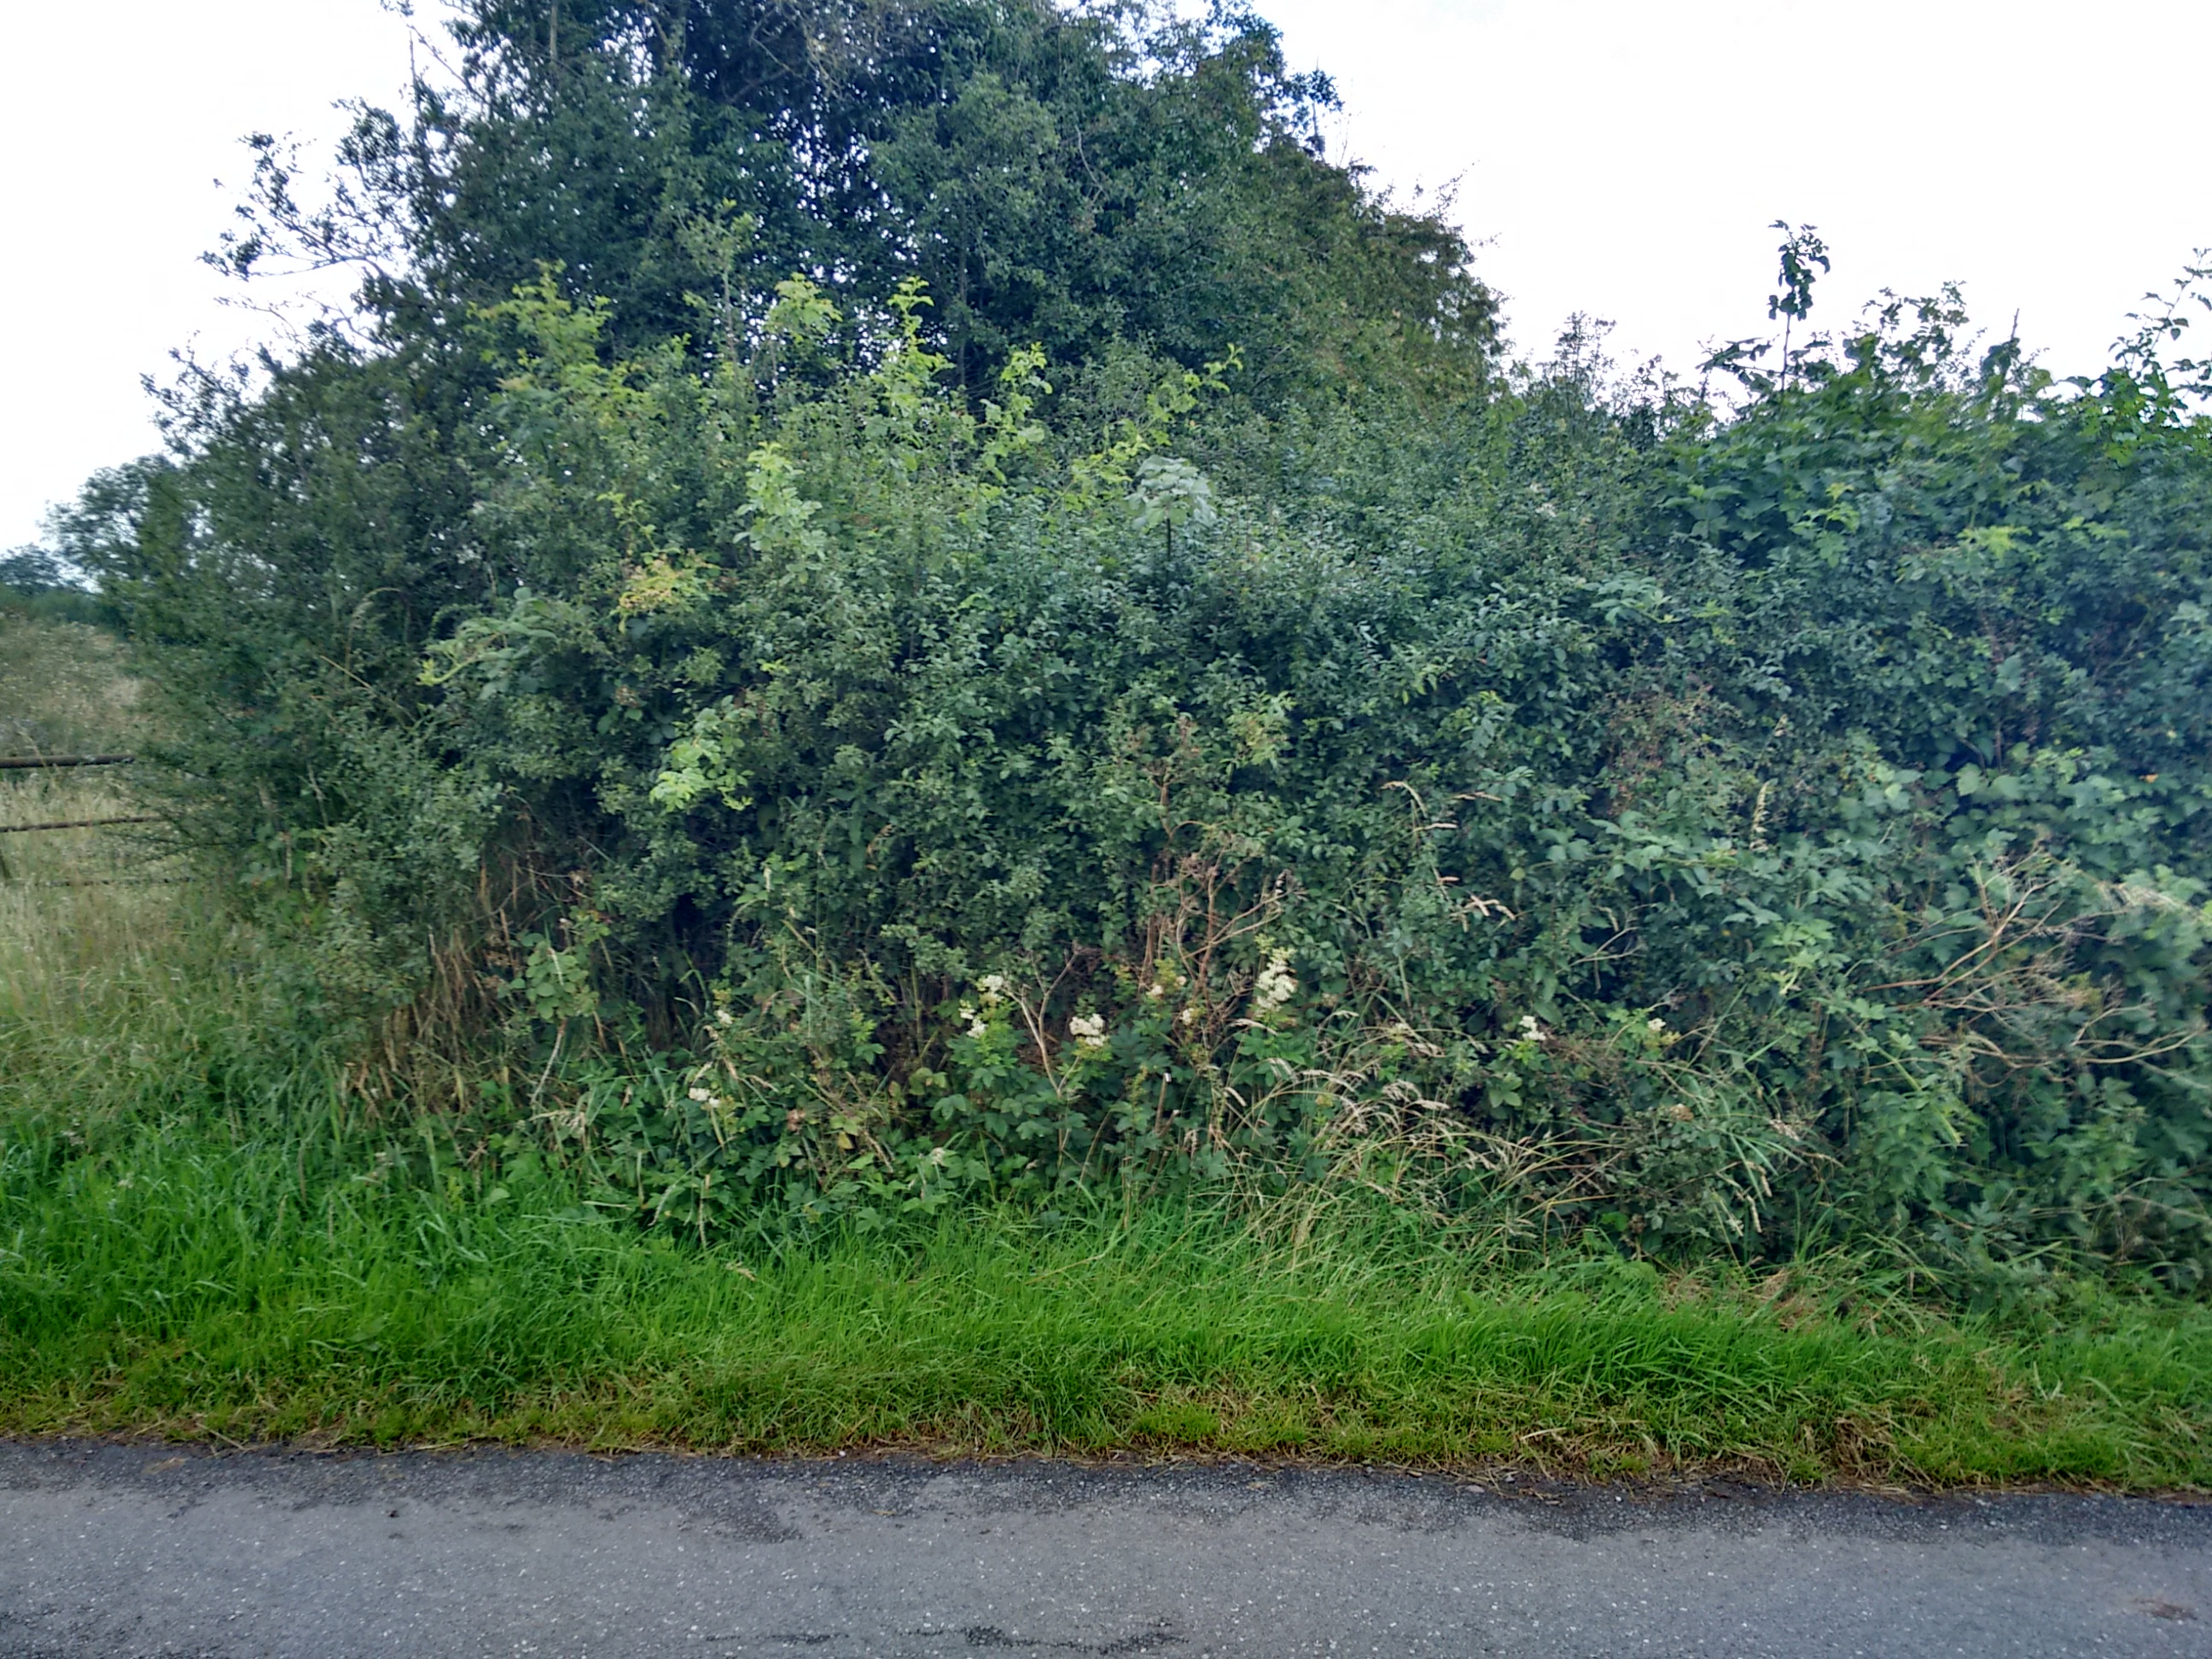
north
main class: Grassland
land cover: Grassland without tree/shrub cover
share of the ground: > 75 %
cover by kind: herbaceous plants 100 %
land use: Agriculture (excluding fallow land and kitchen gardens)
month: August
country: GB
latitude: 54.4026
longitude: -6.8175
